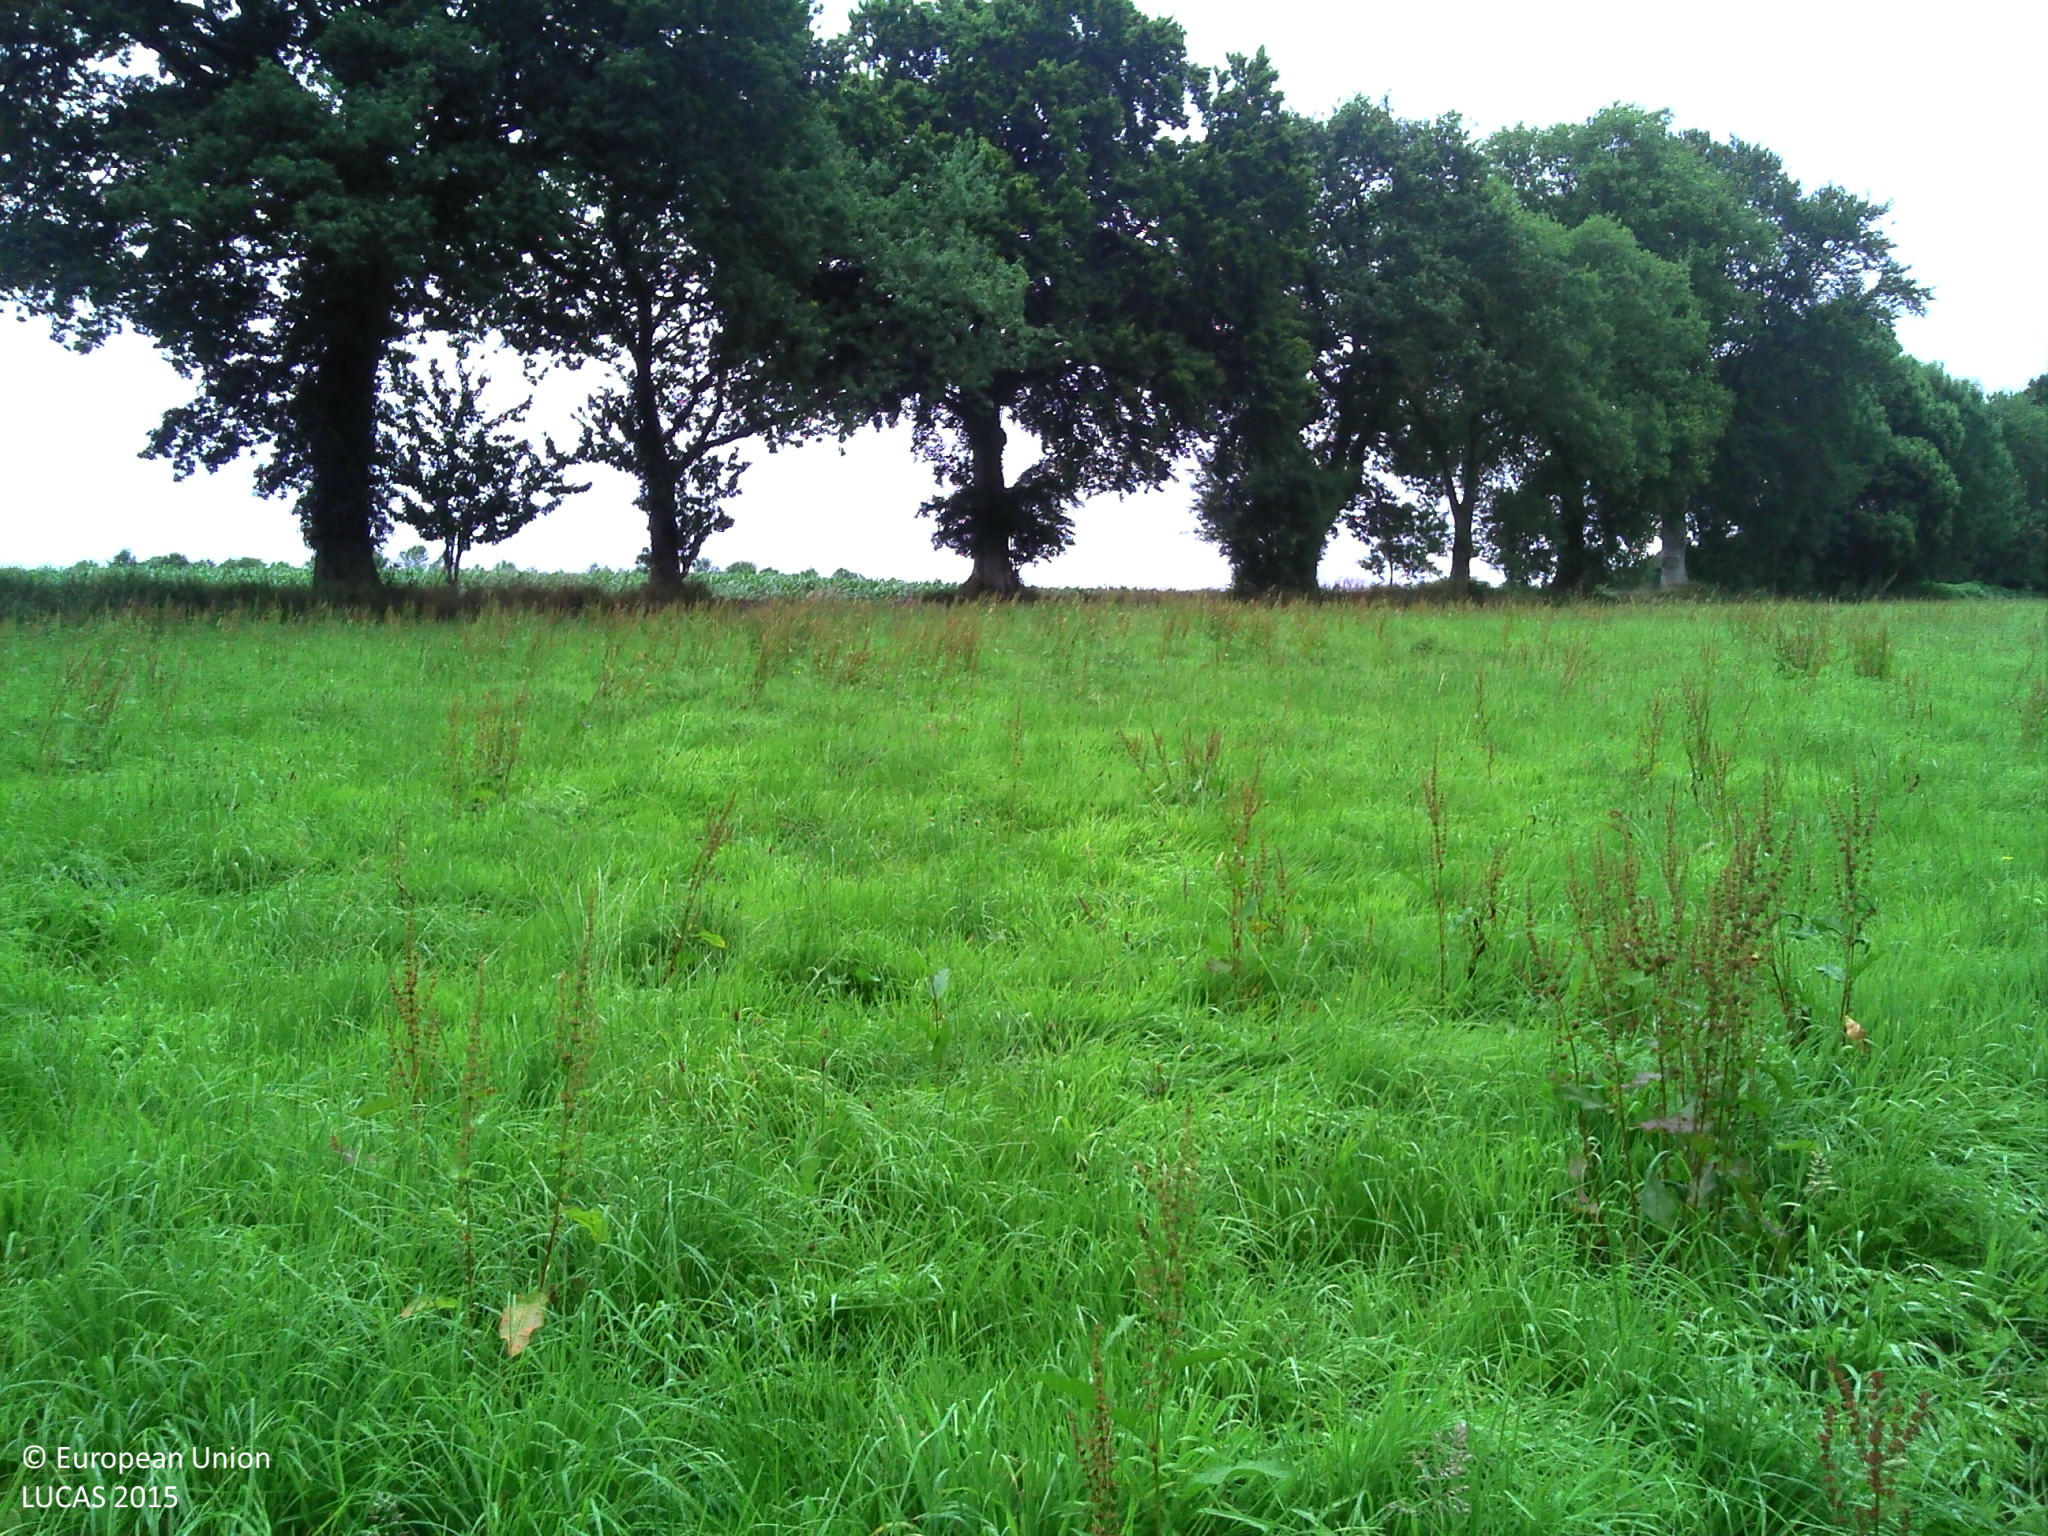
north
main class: Grassland
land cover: Grassland without tree/shrub cover
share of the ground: > 75 %
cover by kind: herbaceous plants 100 %
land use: Agriculture (excluding fallow land and kitchen gardens)
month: July
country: FR
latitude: 48.8914
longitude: -1.3254
